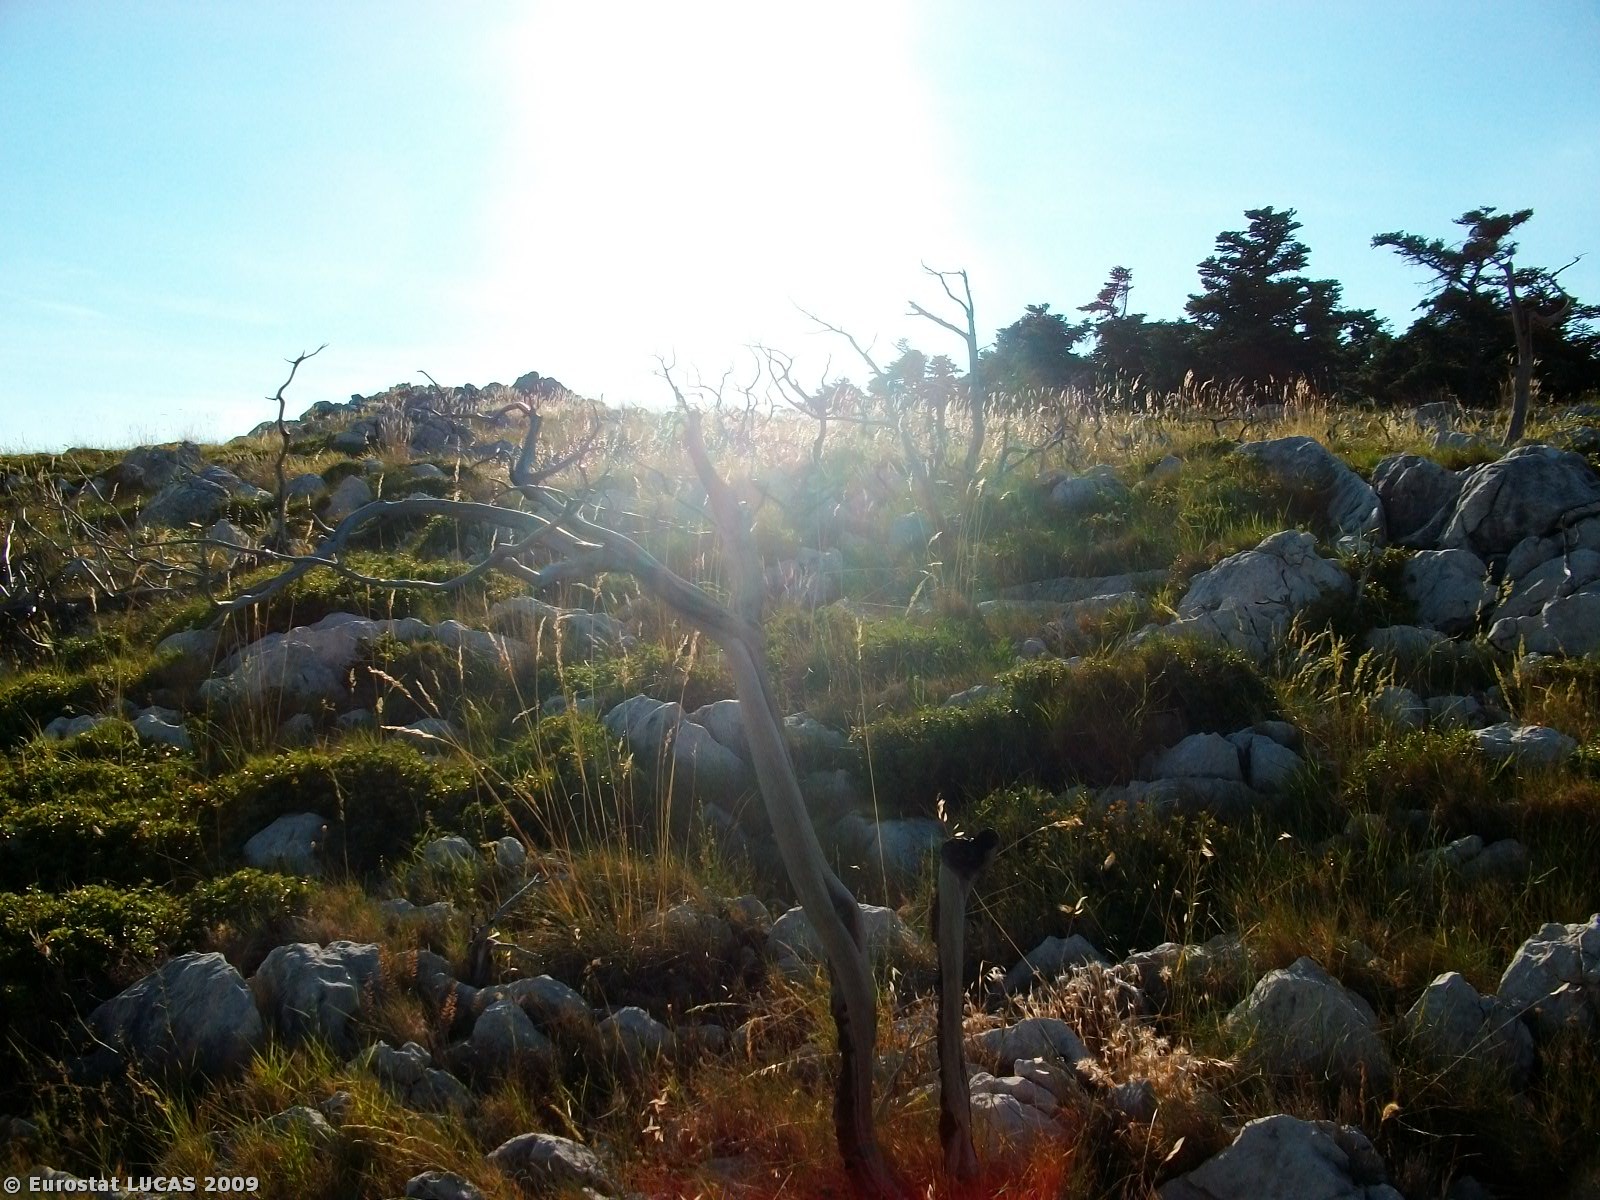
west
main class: Shrubland
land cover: Shrubland without tree cover
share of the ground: 50 - 75 %
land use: Agriculture (excluding fallow land and kitchen gardens)
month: June
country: GR
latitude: 38.2931
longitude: 23.0468
